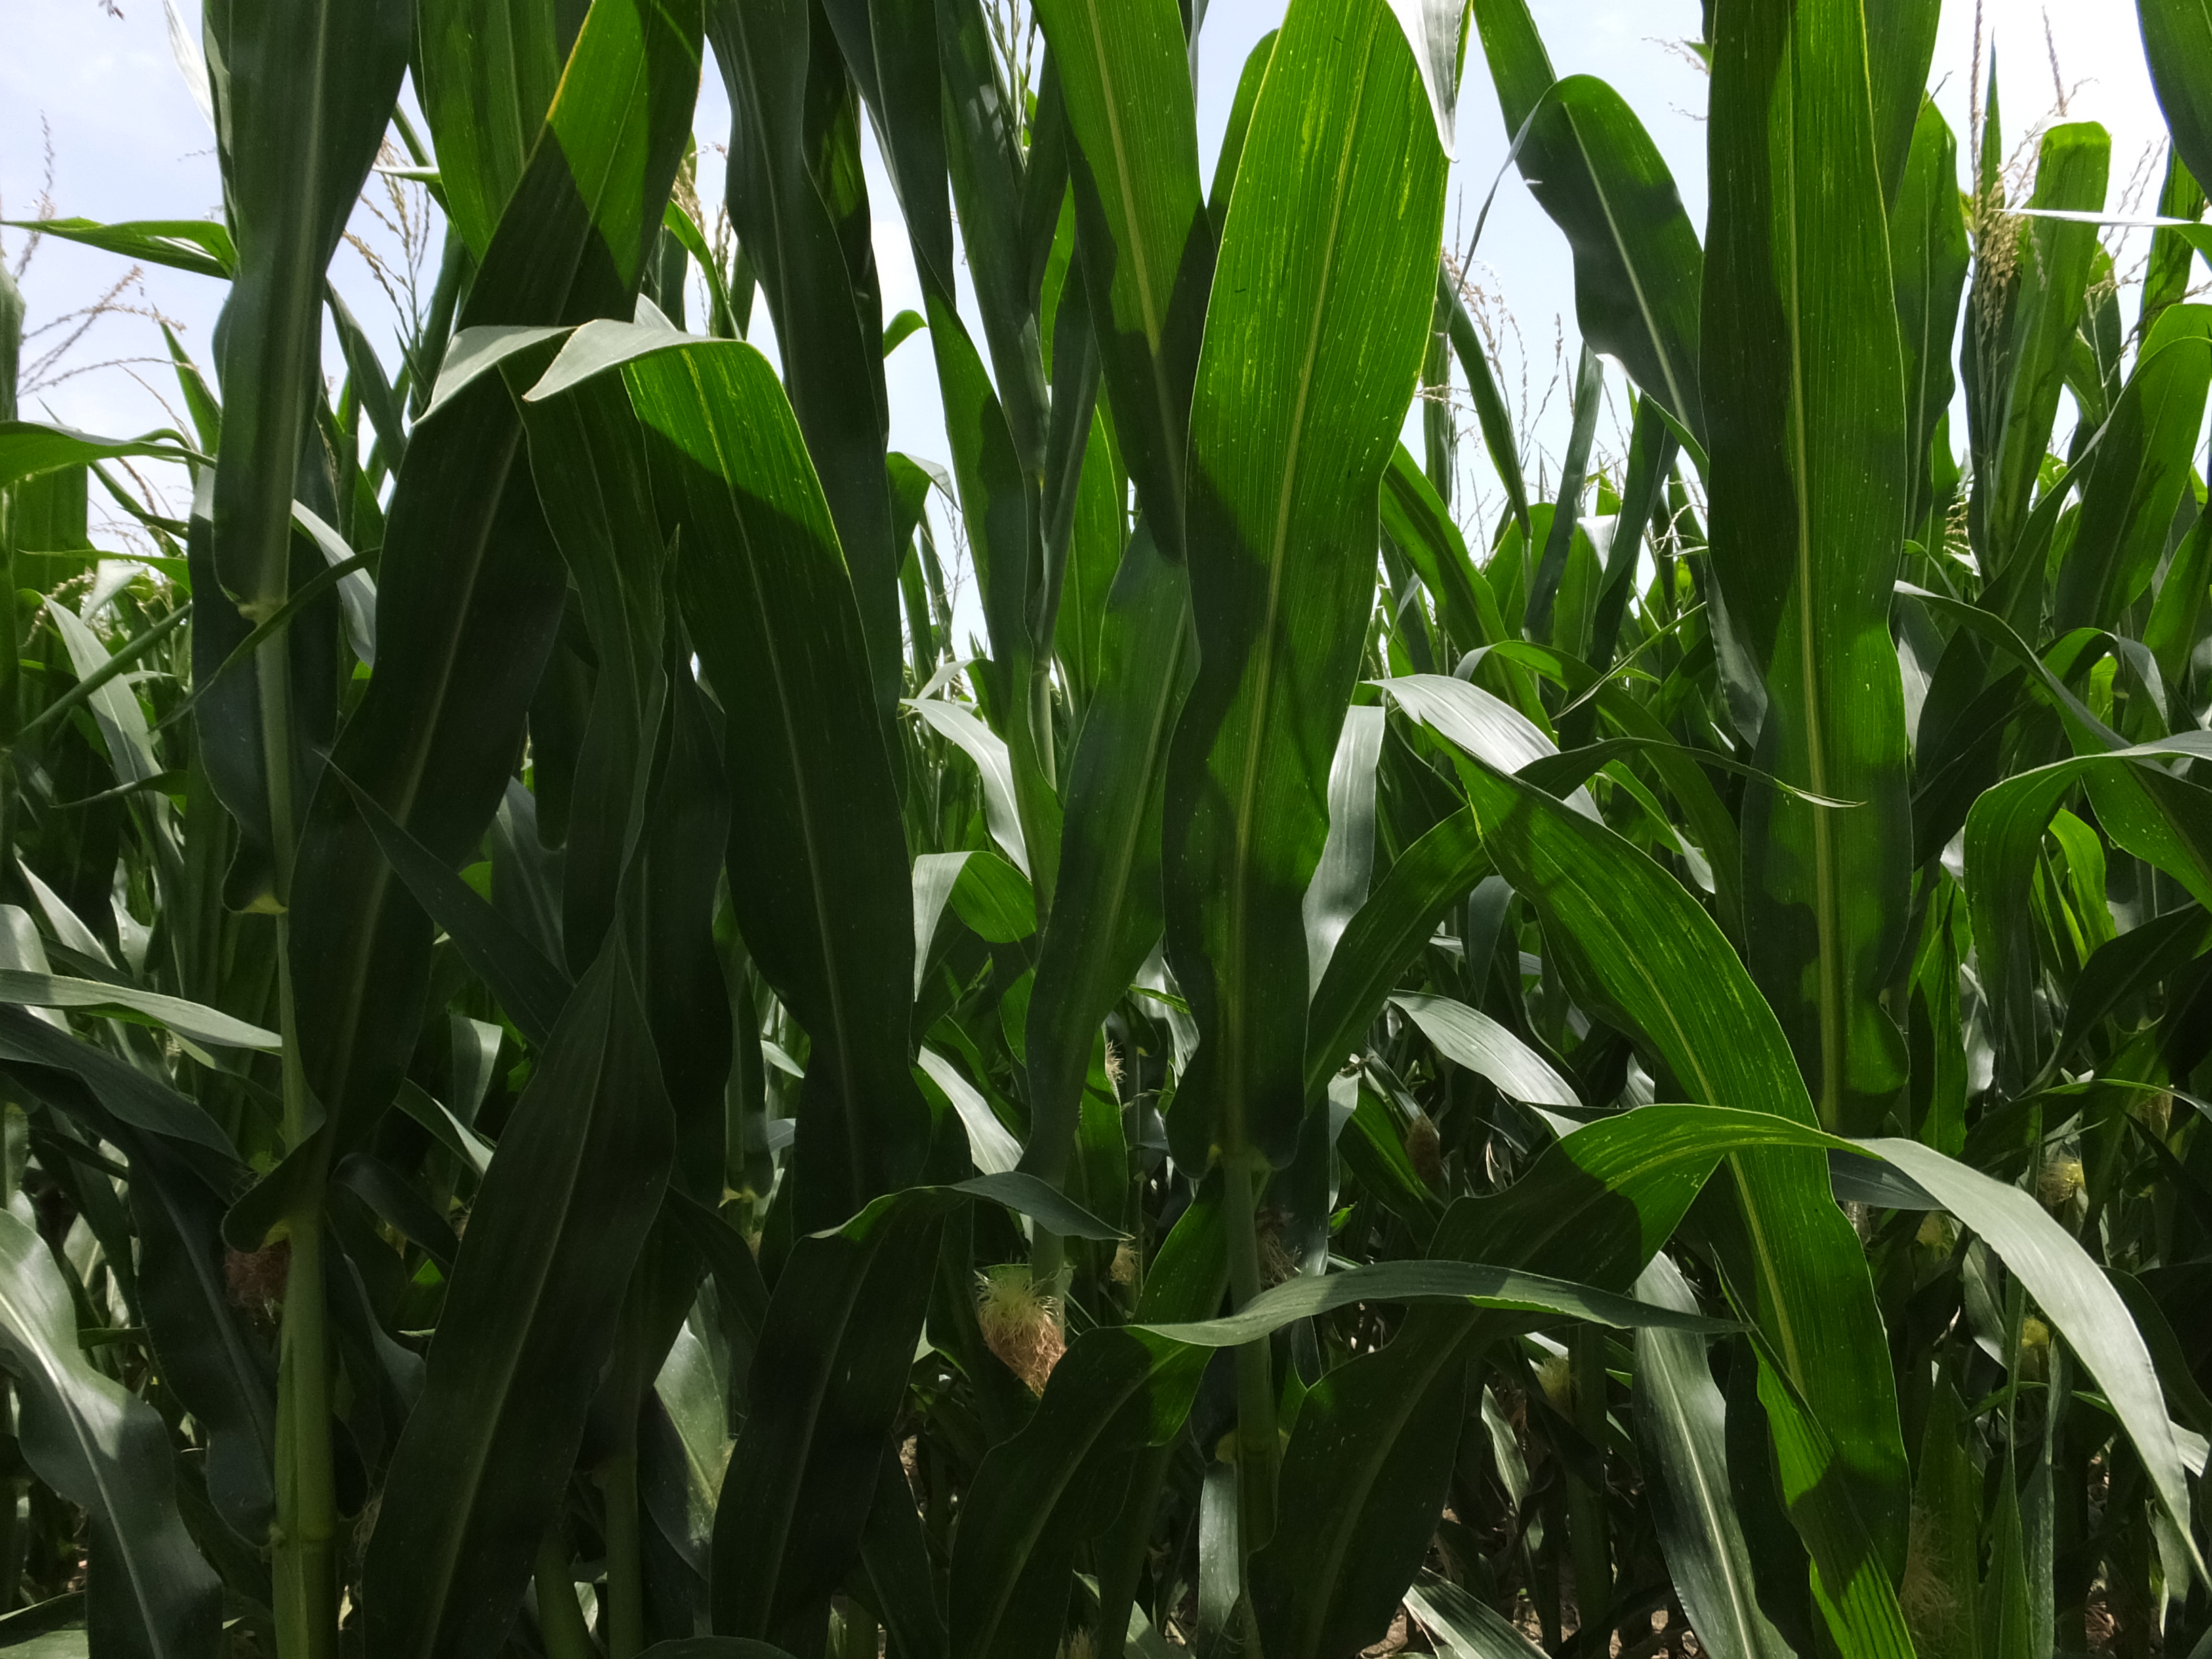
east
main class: Cropland
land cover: Maize
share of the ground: > 75 %
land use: Agriculture (excluding fallow land and kitchen gardens)
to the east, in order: Maize; Grass margins; Maize; Grass margins; Tracks; Grass margins; Other bare soil; Grass margins; Tracks; Grass margins; Other bare soil
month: July
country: ES
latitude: 41.7351
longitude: 0.1374
